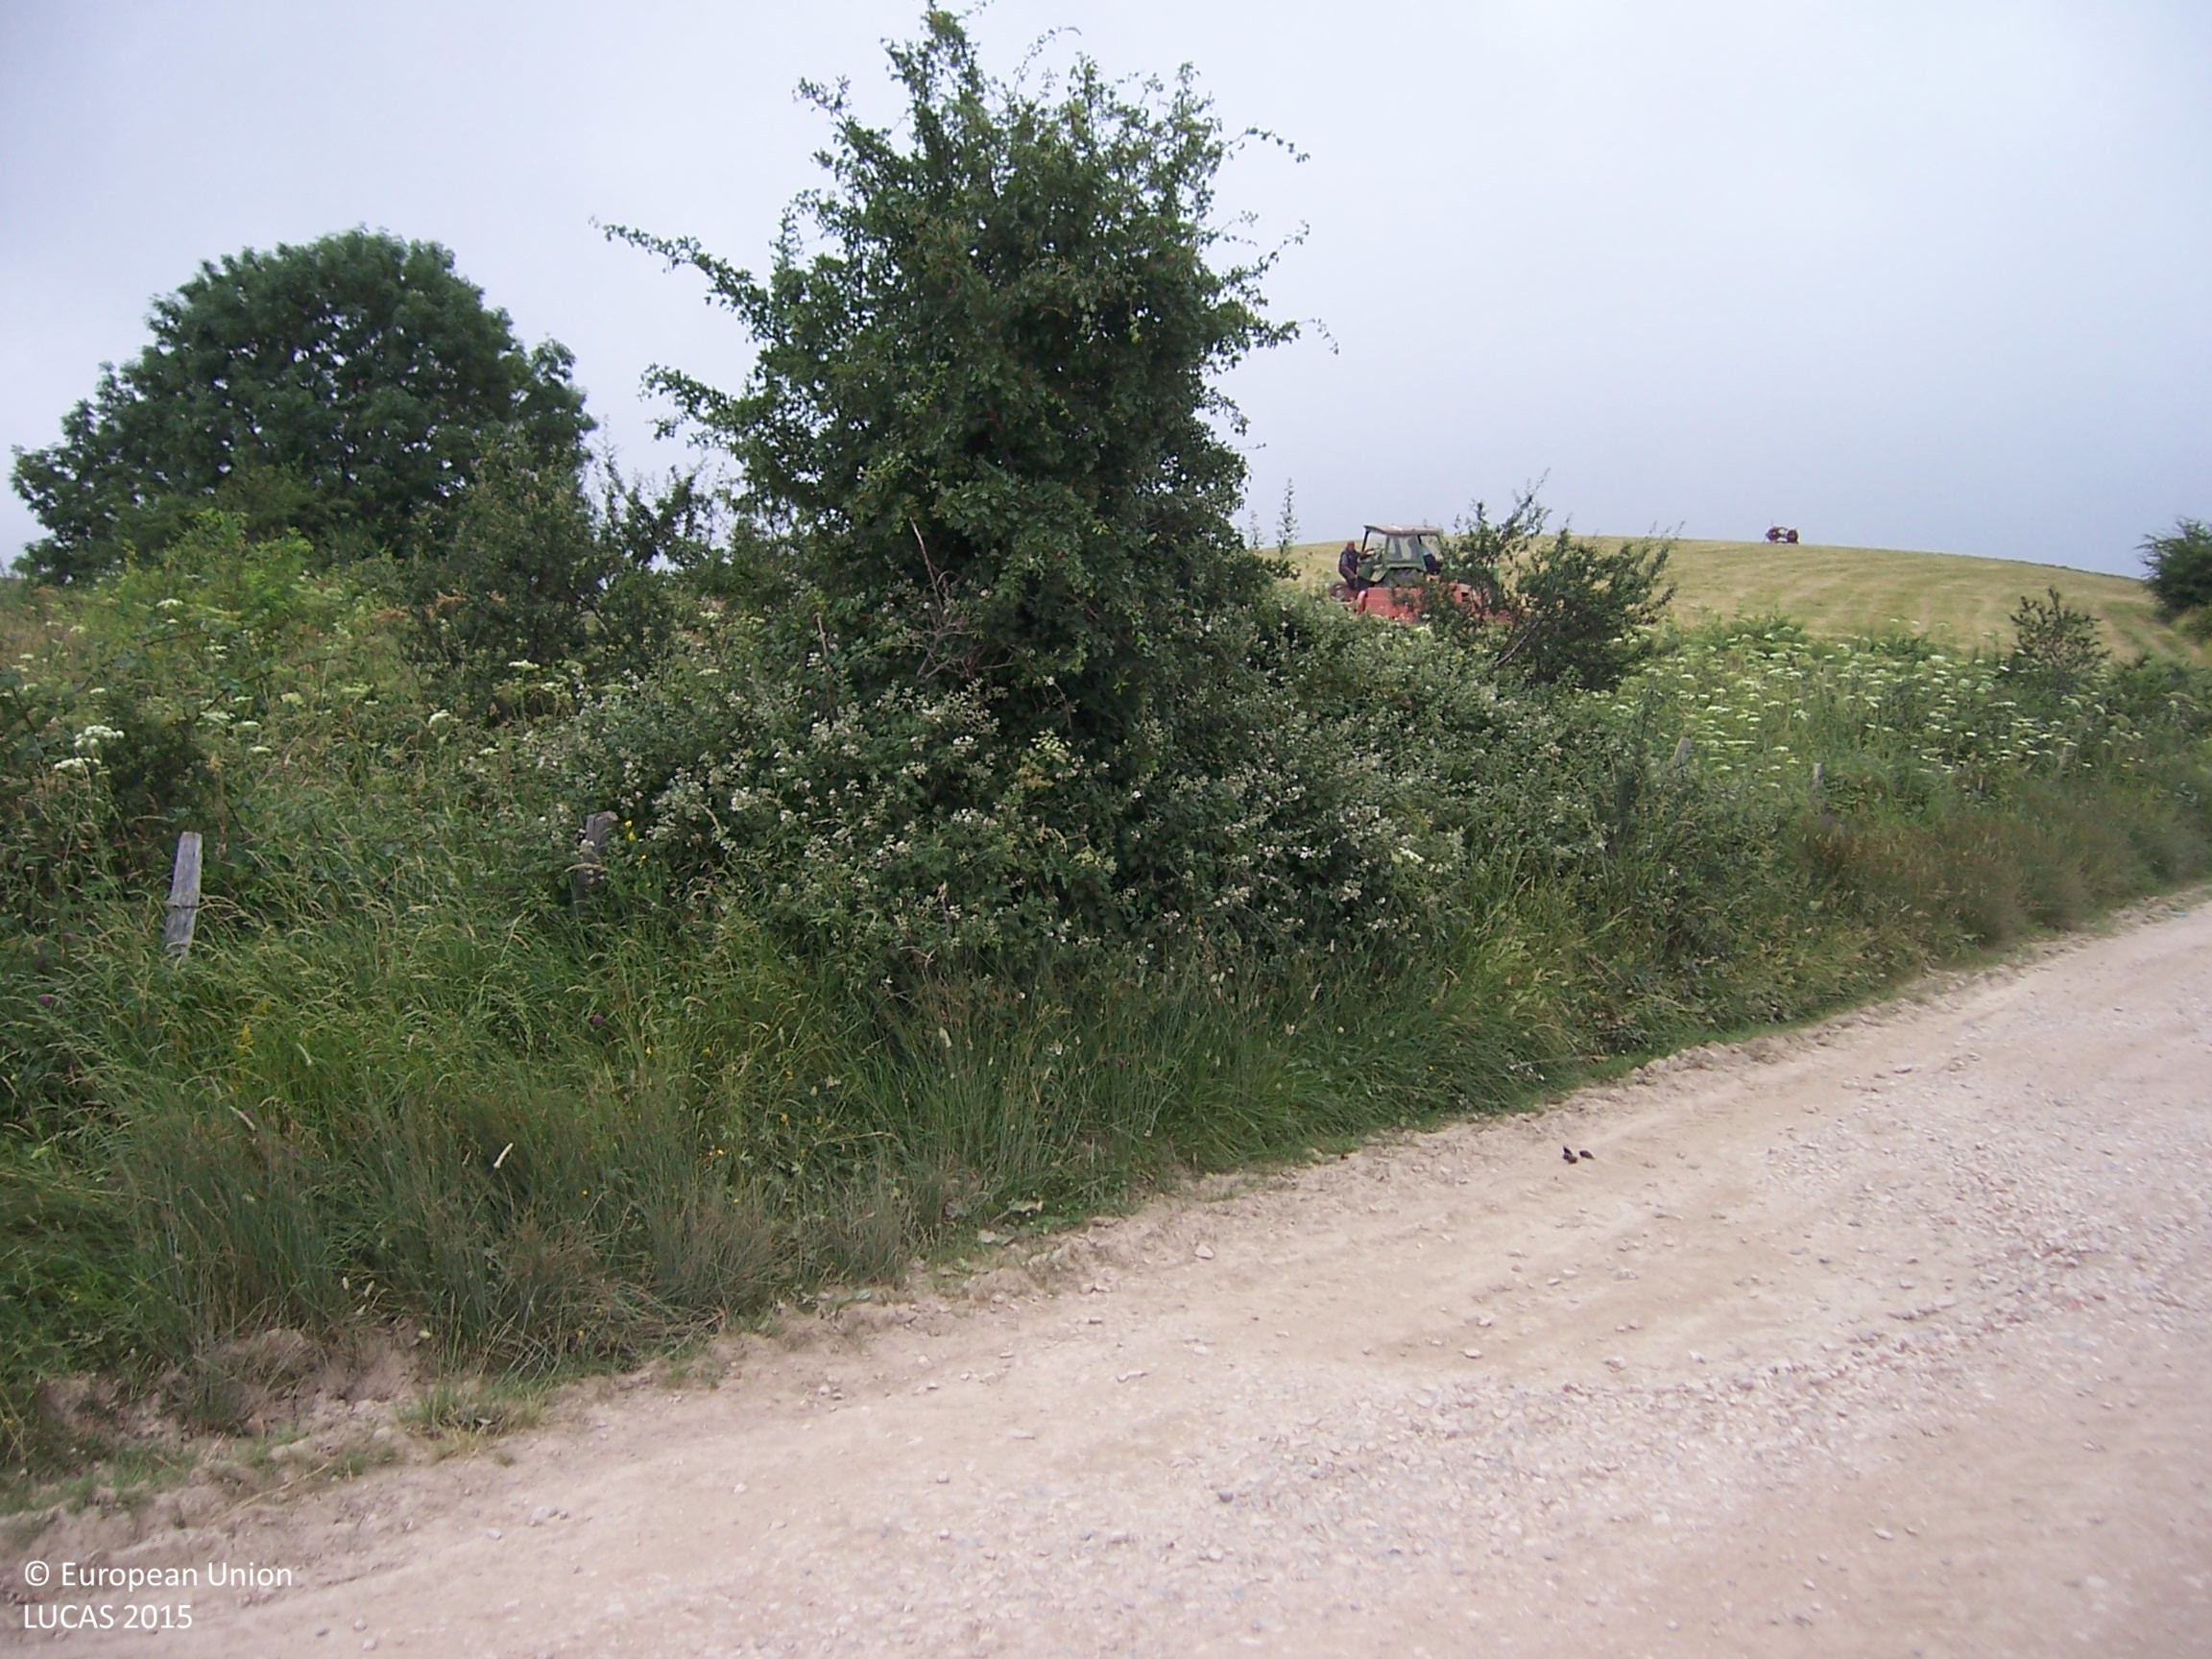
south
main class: Grassland
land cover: Grassland without tree/shrub cover
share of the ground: > 75 %
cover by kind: herbaceous plants 100 %
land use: Agriculture (excluding fallow land and kitchen gardens)
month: July
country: ES
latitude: 42.9663
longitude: -1.3039
